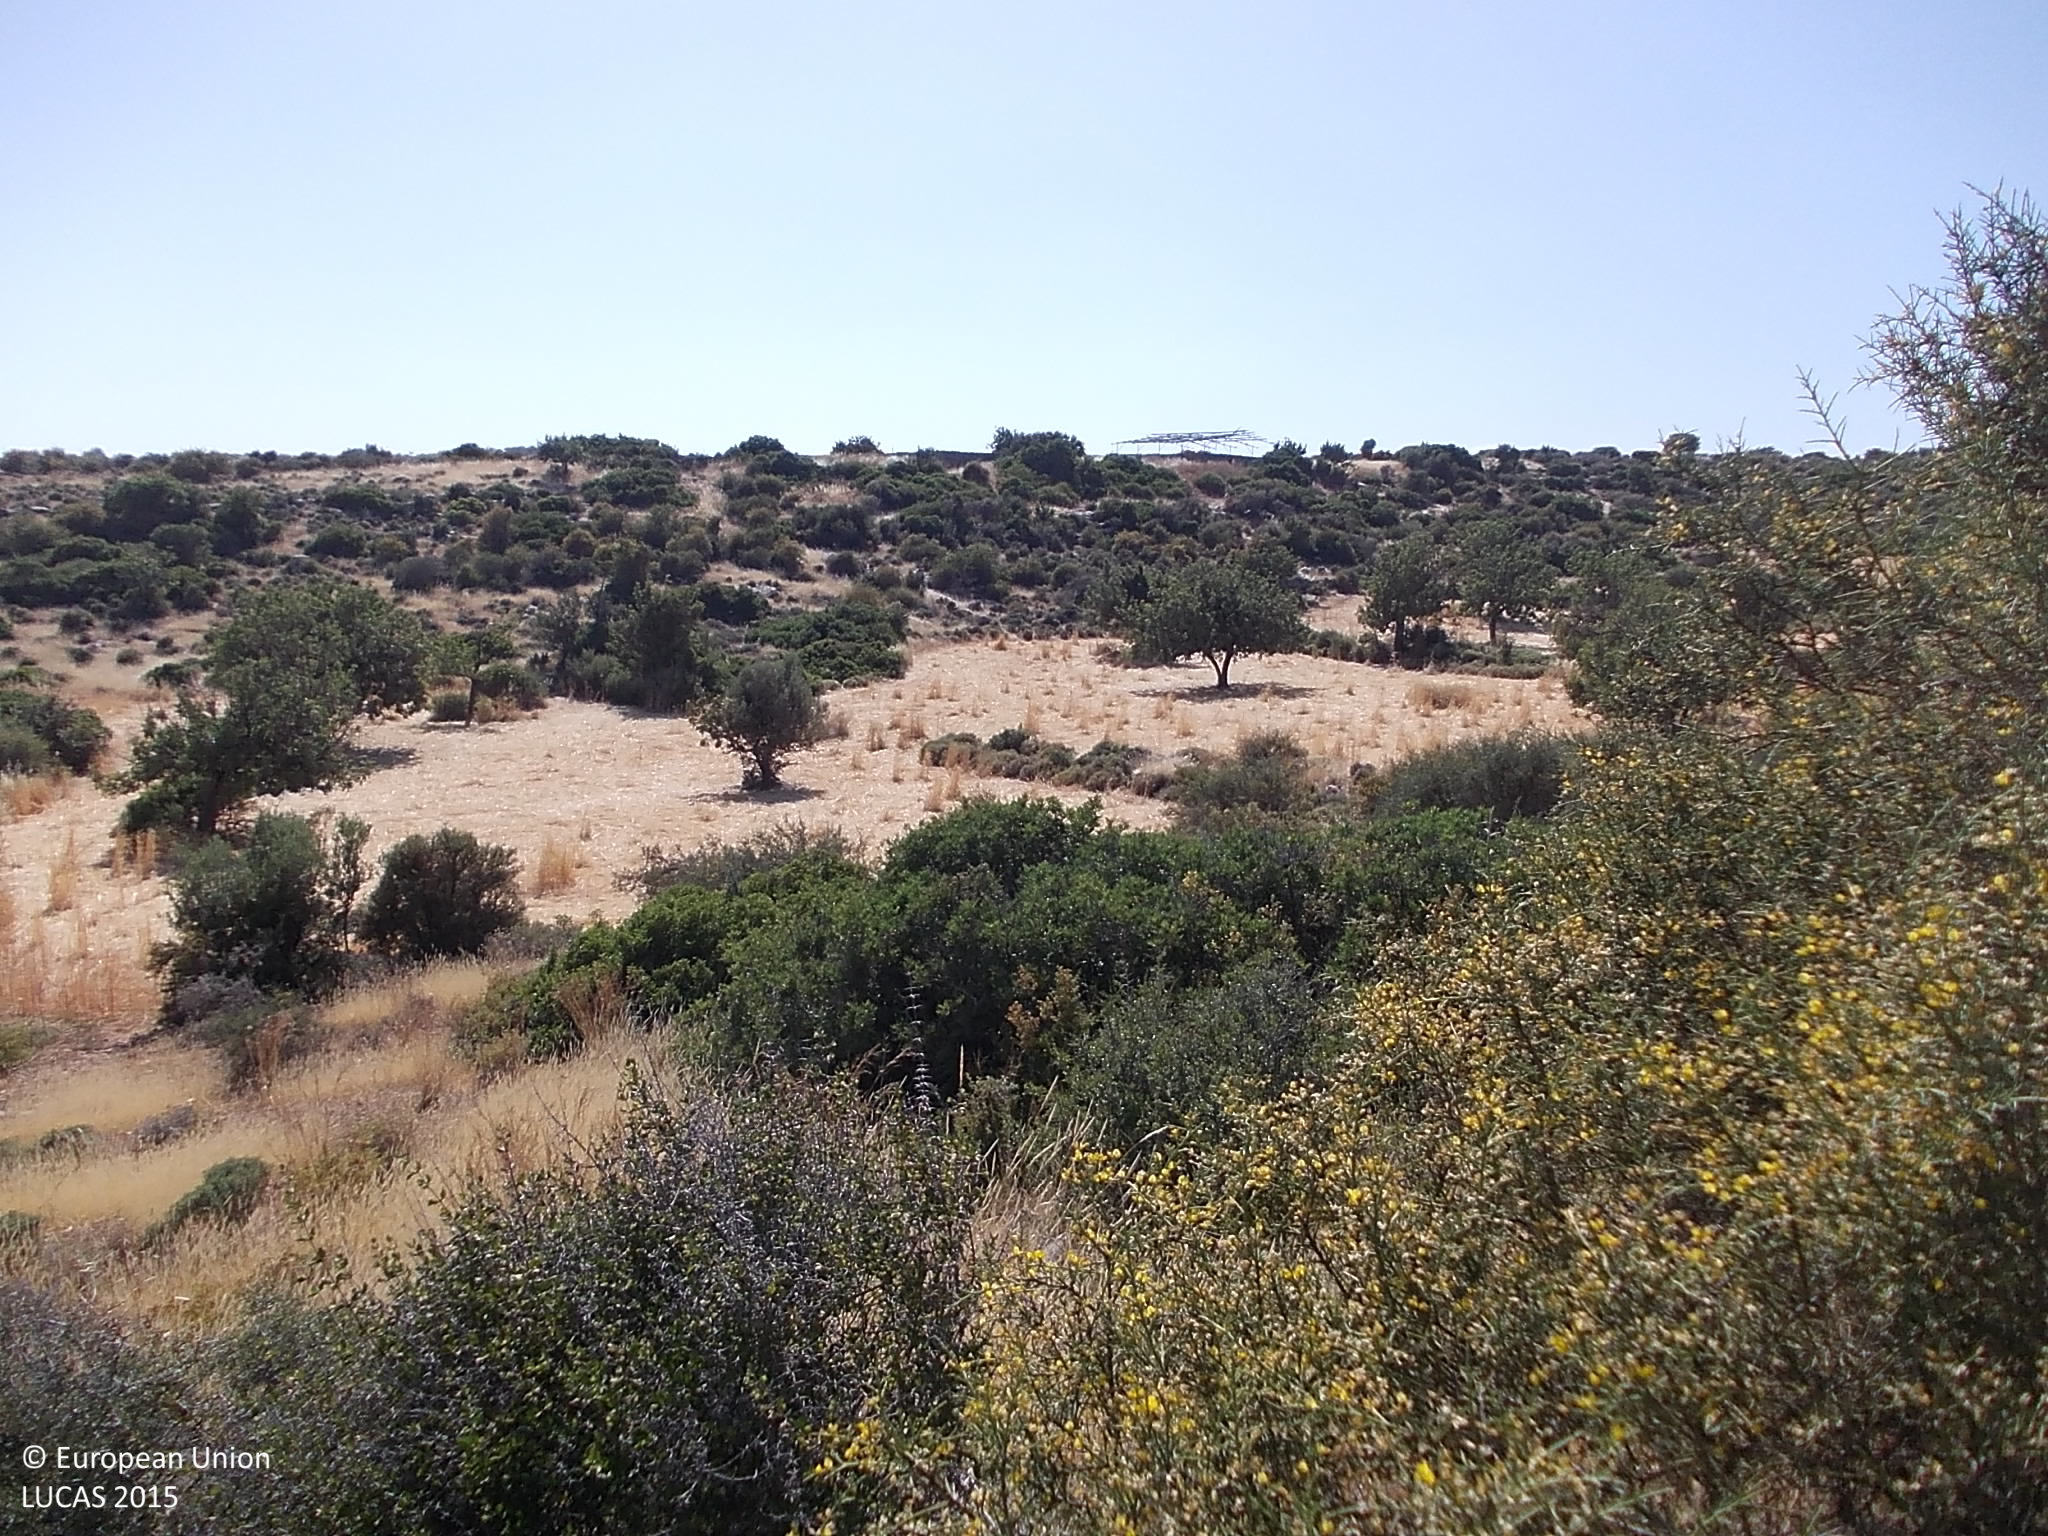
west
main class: Shrubland
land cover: Shrubland with sparse tree cover
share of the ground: > 75 %
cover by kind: shrubs 75 %, unconsolidated bare surface 20 %, broadleaved forest trees 5 %
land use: Semi-natural and natural areas not in use
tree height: < 5 m
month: May
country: CY
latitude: 34.7197
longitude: 32.9973
